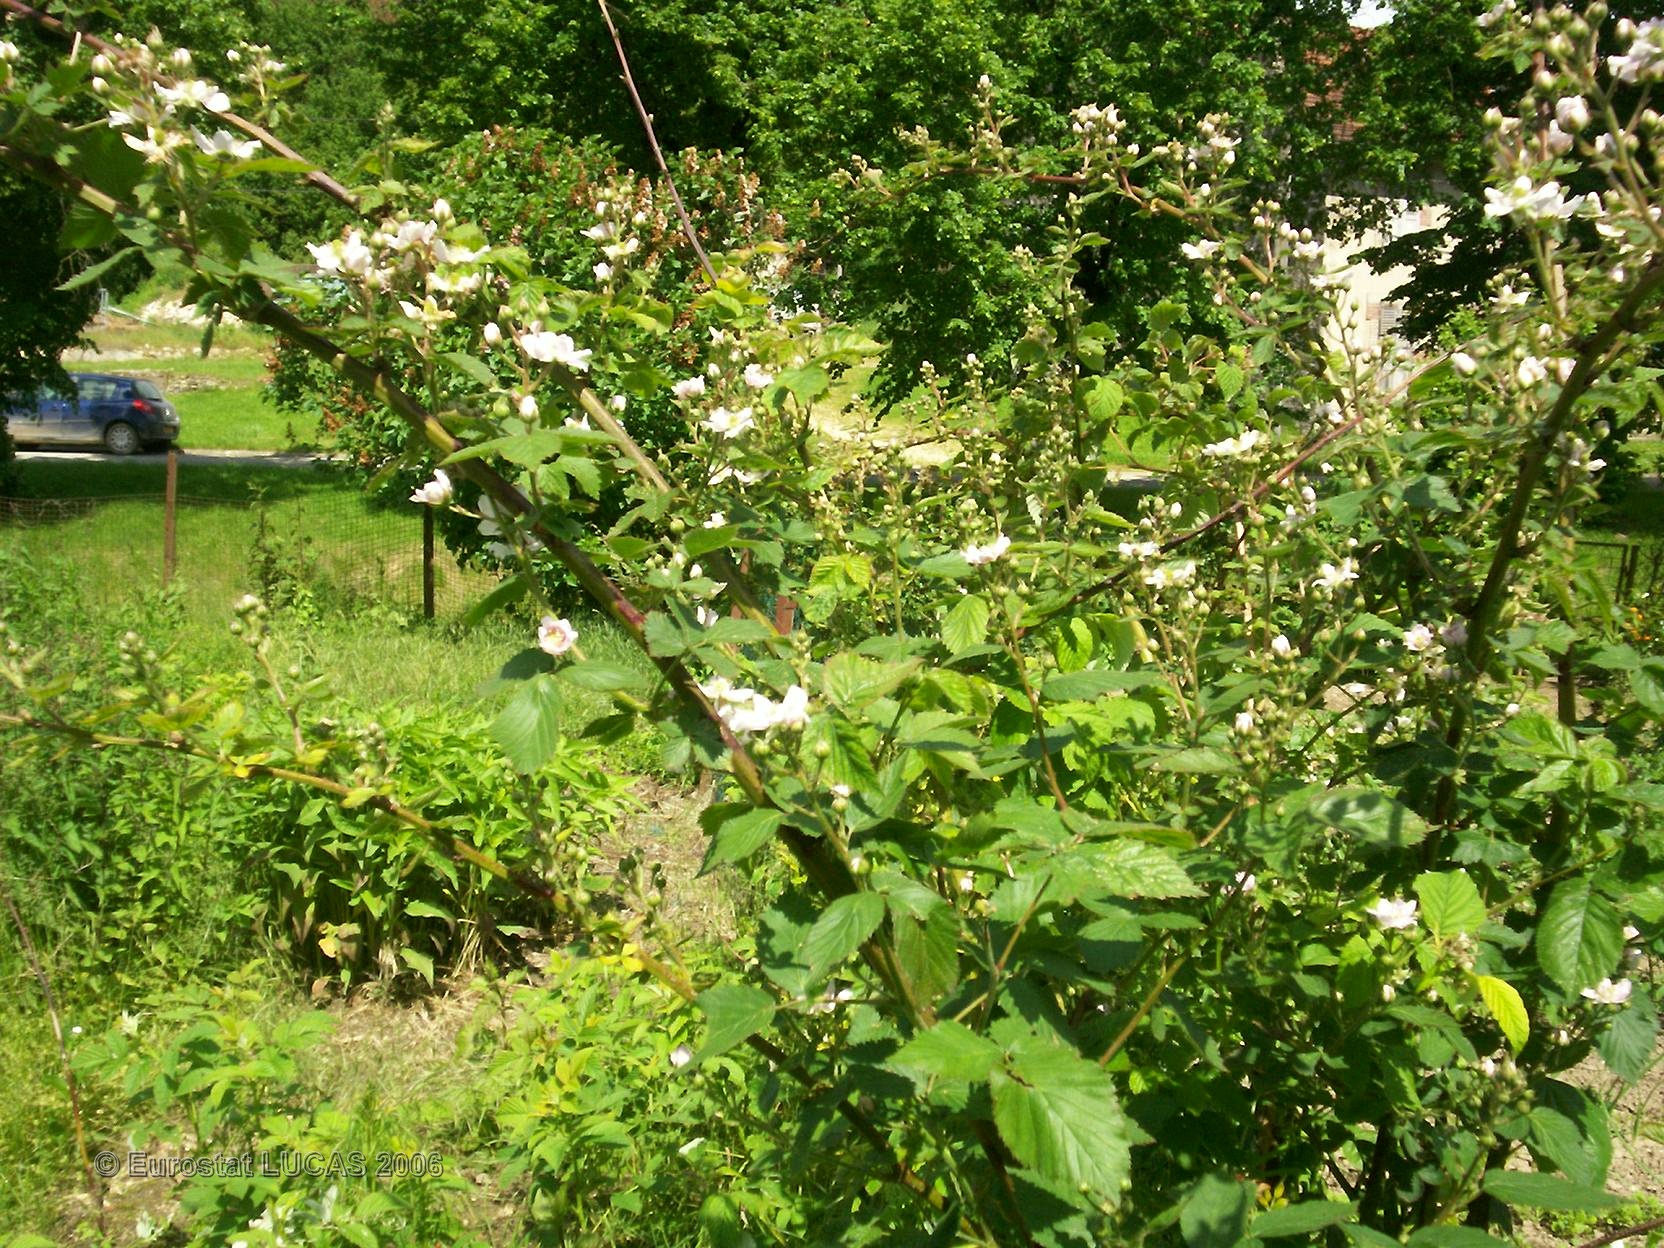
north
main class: Cropland
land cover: Other fresh vegetables
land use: Kitchen garden
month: June
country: FR
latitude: 49.2486
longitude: 5.0661
